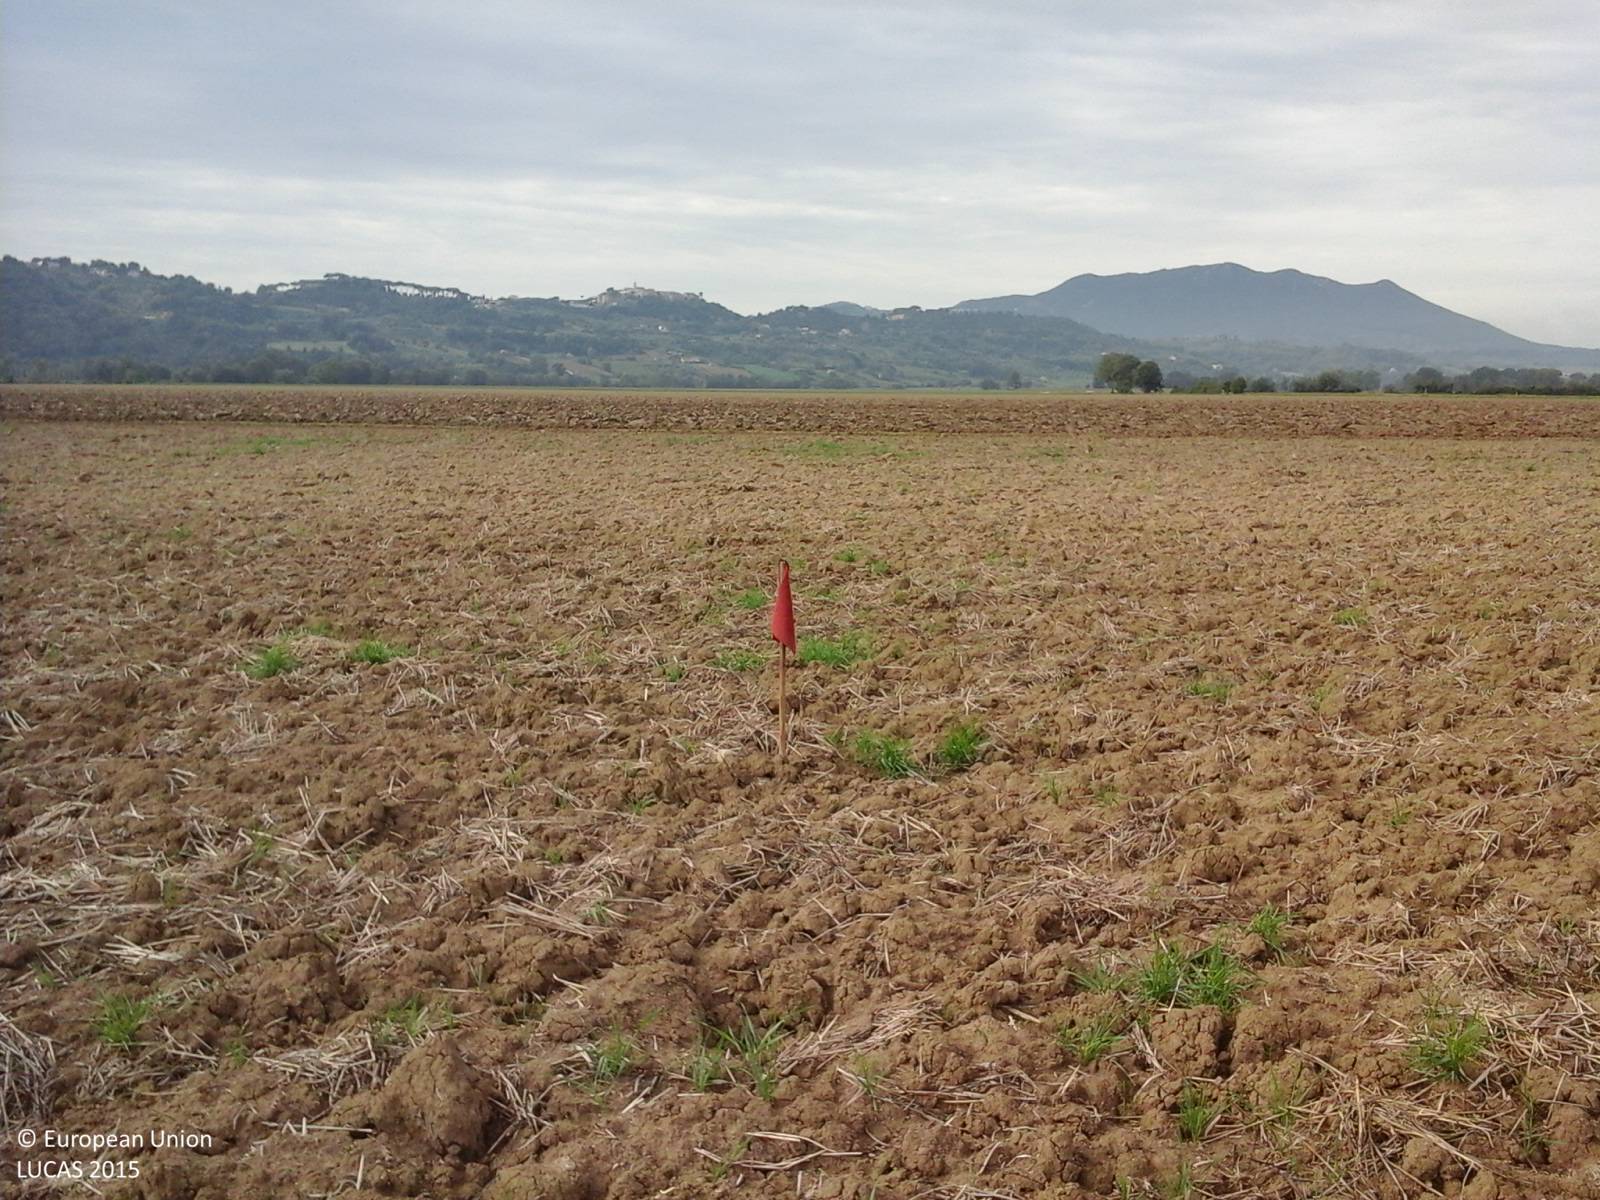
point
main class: Cropland
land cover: Durum wheat
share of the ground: < 10 %
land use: Agriculture (excluding fallow land and kitchen gardens)
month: October
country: IT
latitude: 42.2773
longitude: 12.5981
